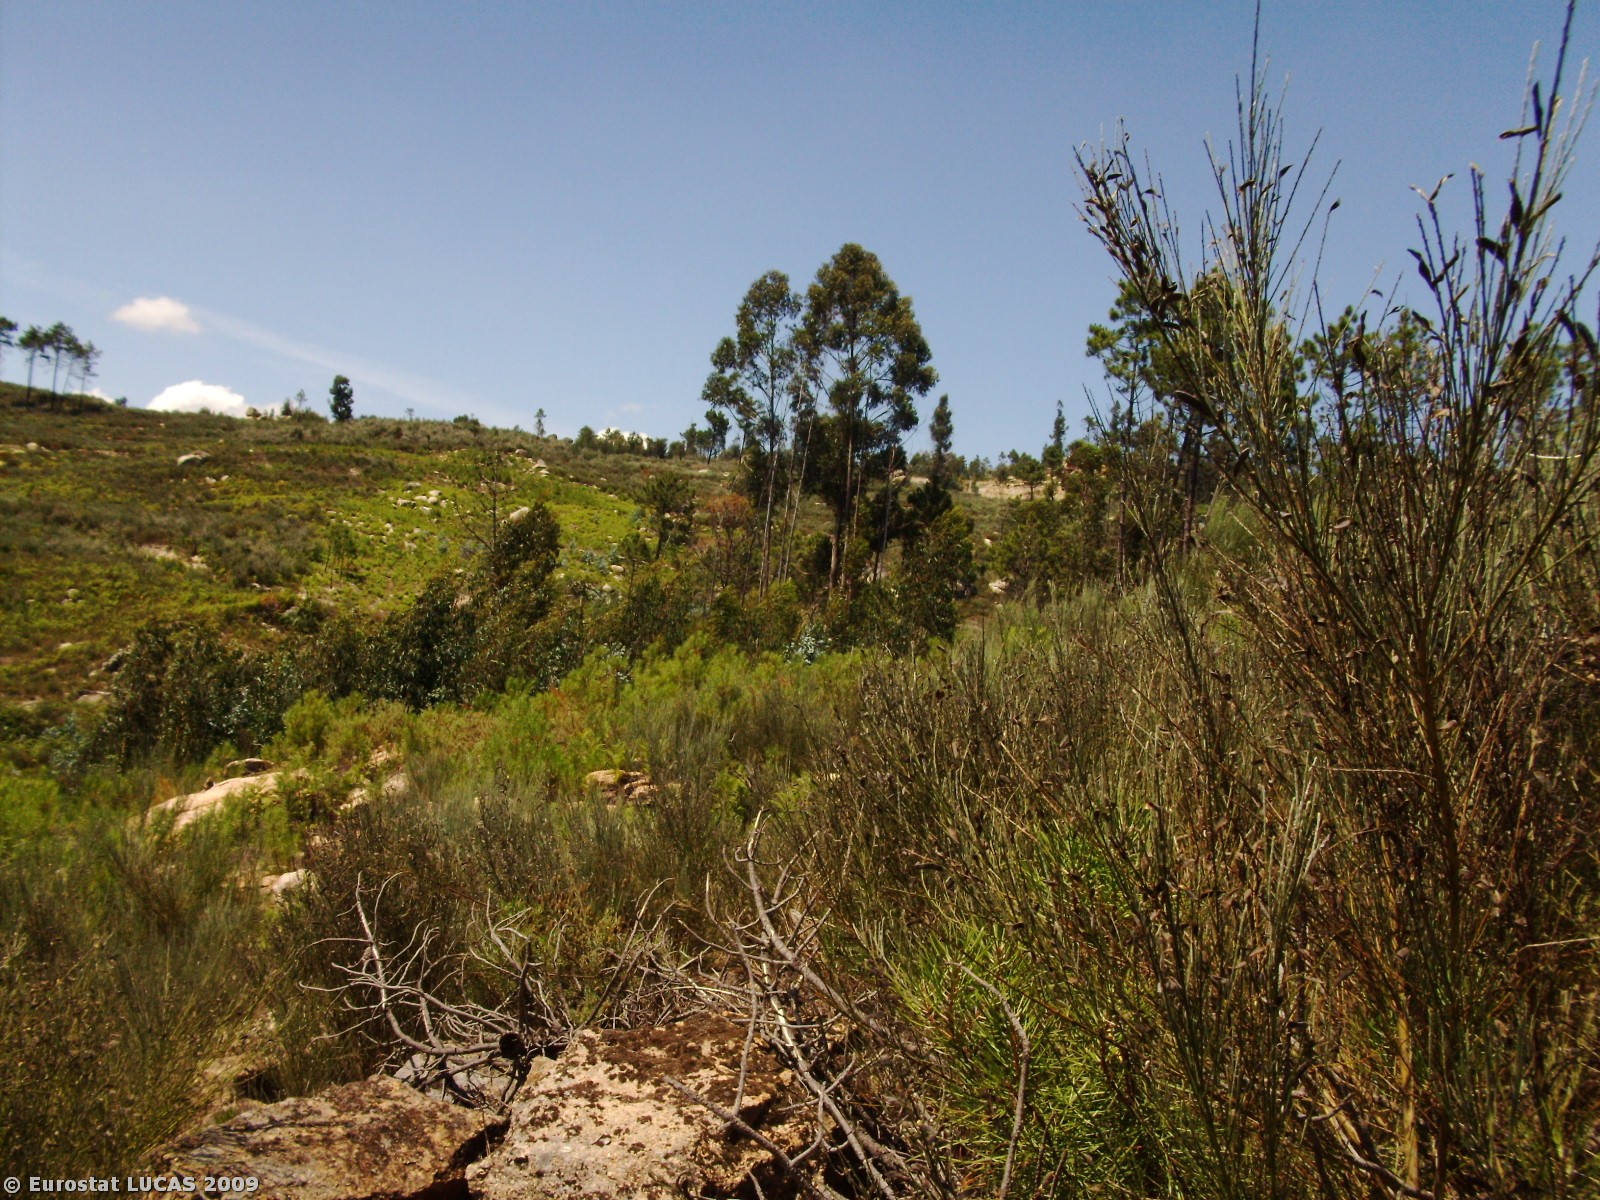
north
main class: Shrubland
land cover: Shrubland without tree cover
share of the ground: 50 - 75 %
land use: Unused
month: July
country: PT
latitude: 40.6851
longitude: -7.6414
